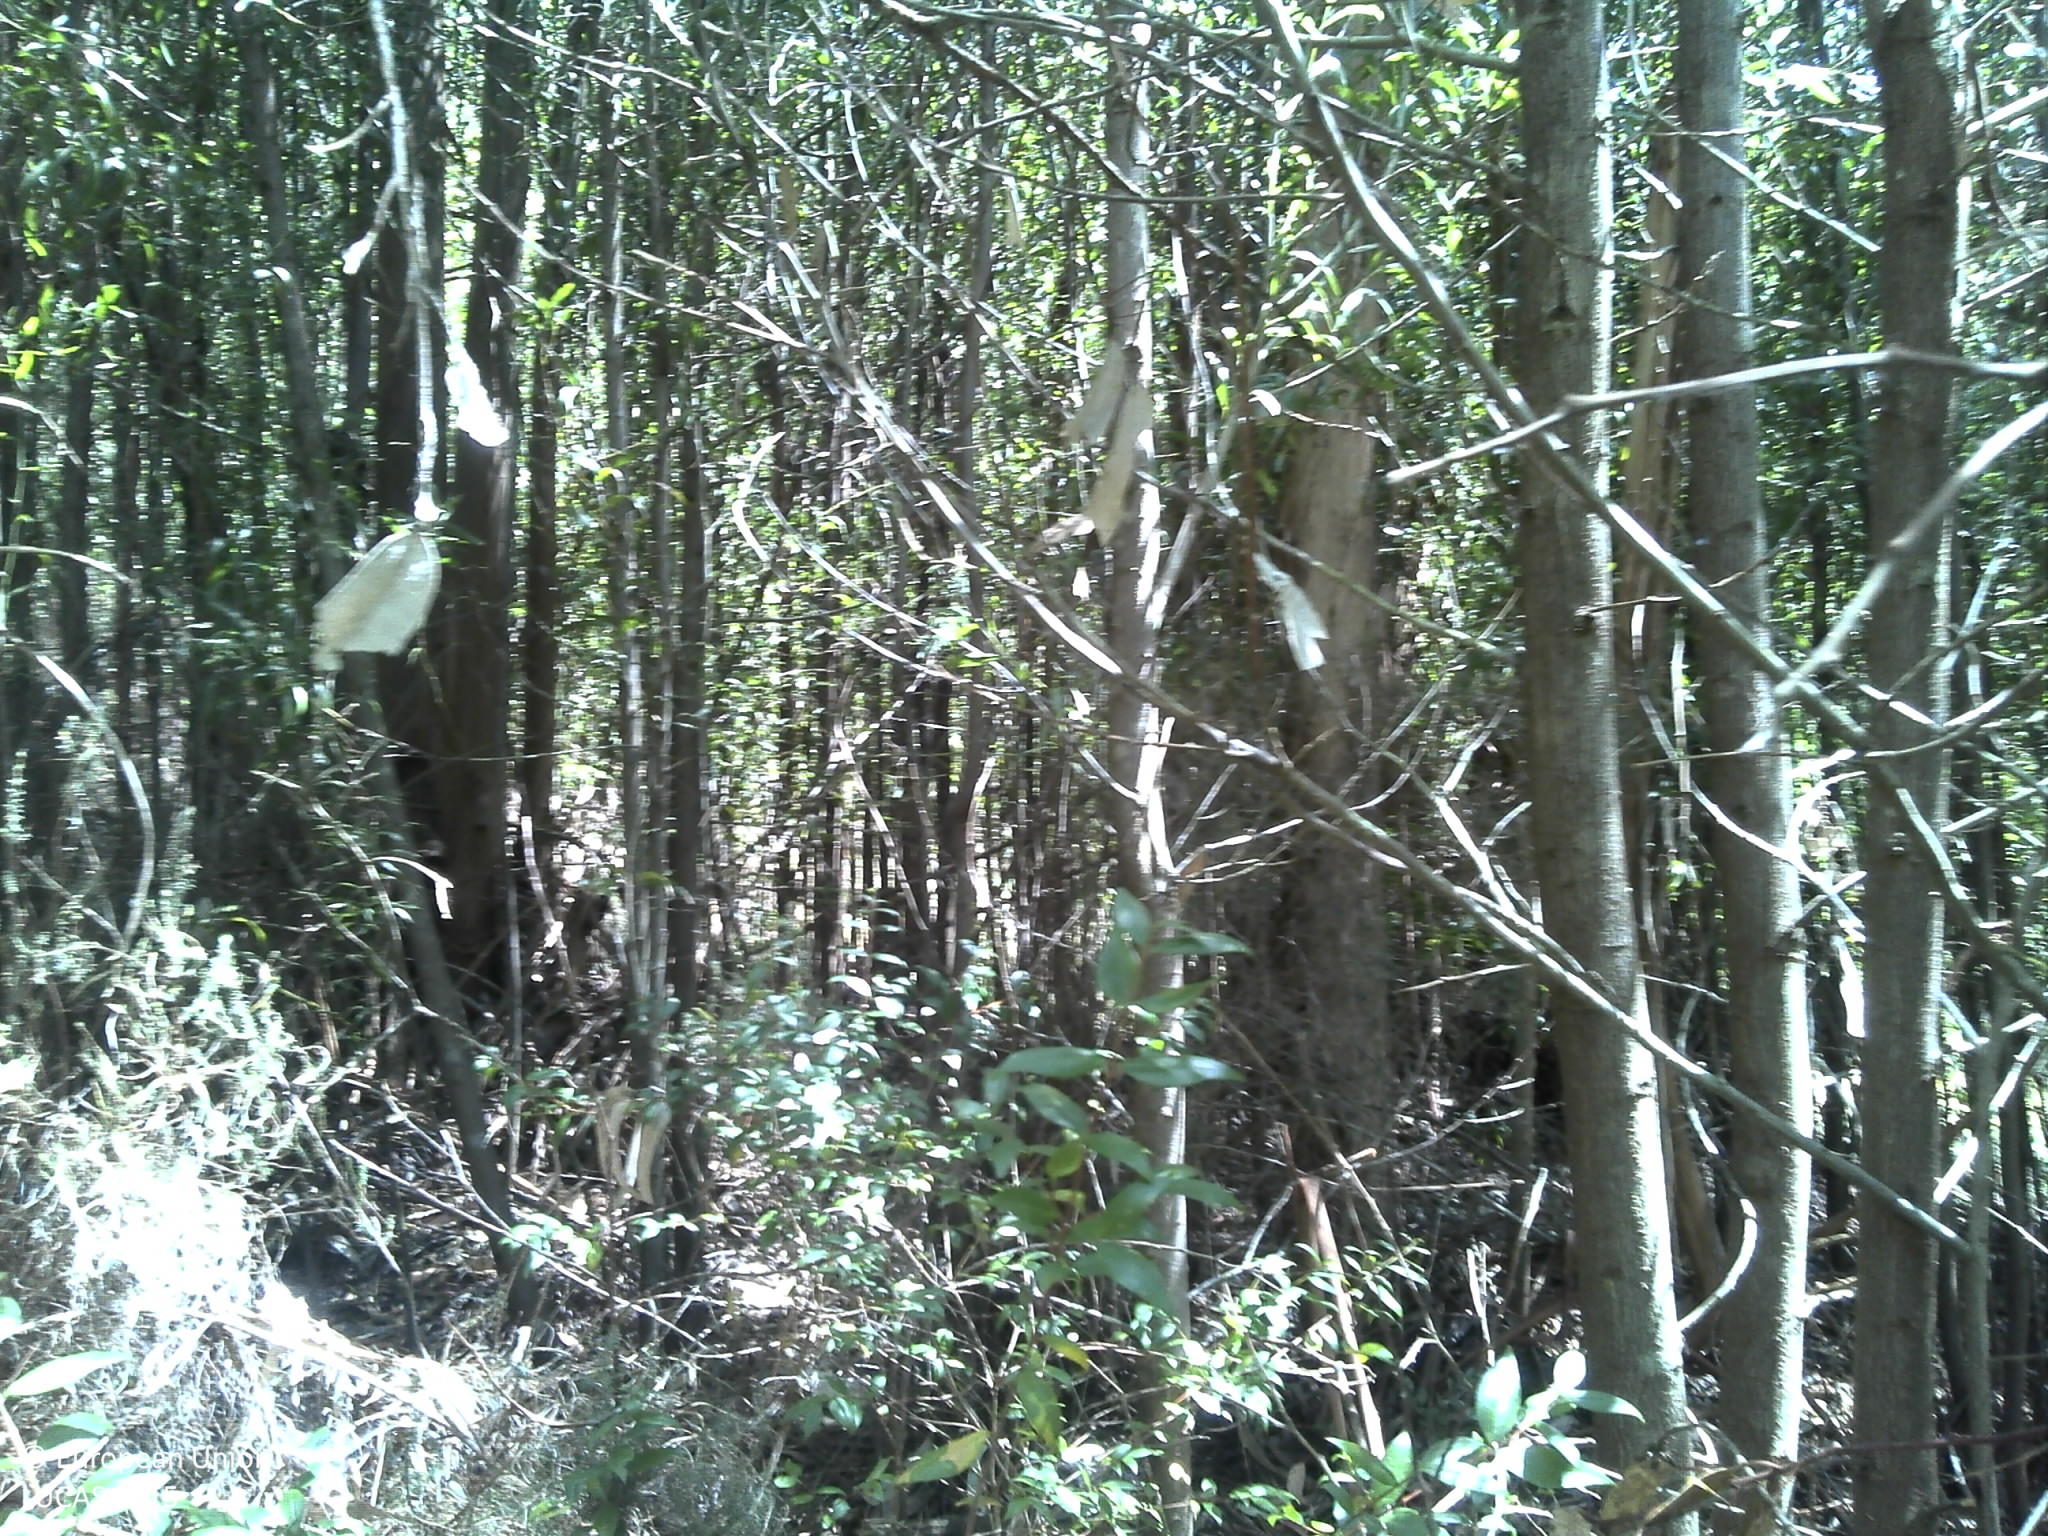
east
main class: Woodland
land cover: Broadleaved woodland
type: exotic forest
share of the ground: > 75 %
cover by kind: broadleaved forest trees 80 %, shrubs 10 %, herbaceous plants 5 %, unconsolidated bare surface 5 %
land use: Forestry
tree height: > 5 m
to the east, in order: Broadleaved woodland; Arable land (only in case pi); Fences; Arable land (only in case pi); Artificial constructions in urban areas; Permanent crops (only in case pi)
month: May
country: PT
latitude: 40.5131
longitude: -8.6602
